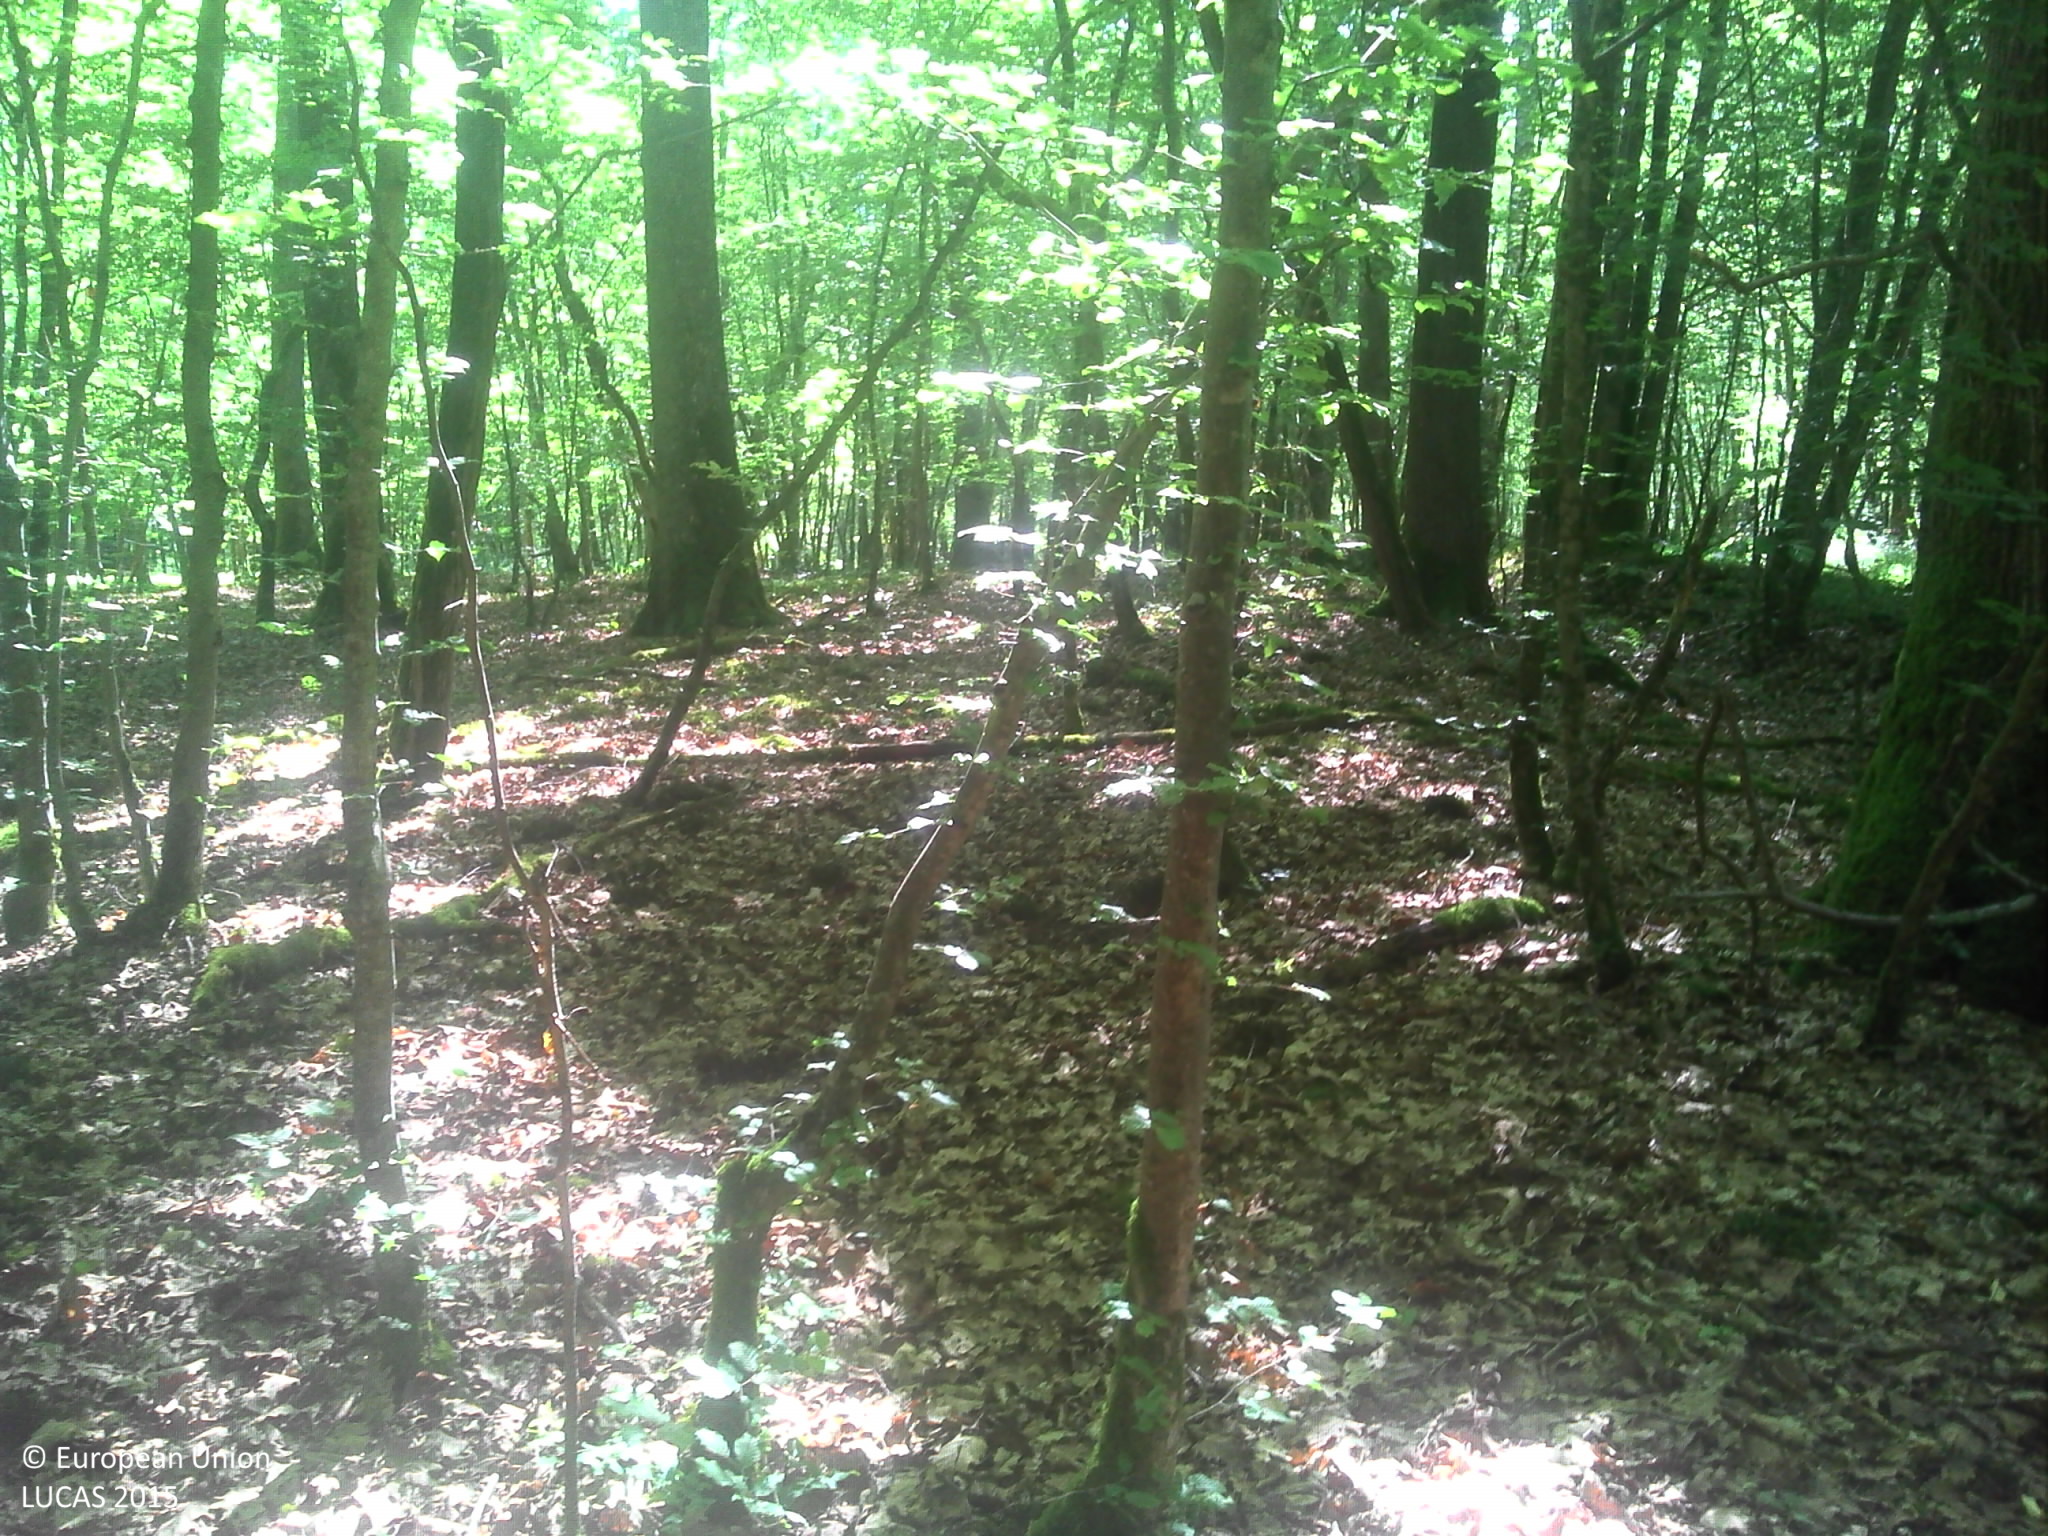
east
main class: Woodland
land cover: Broadleaved woodland
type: acidophilous oak and oak-birch forest
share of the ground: > 75 %
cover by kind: broadleaved forest trees 85 %, herbaceous plants 10 %, coniferous forest trees 5 %
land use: Forestry
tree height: > 5 m
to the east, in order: Broadleaved woodland; Tracks; Broadleaved woodland; Ditches and canals; Tracks; Ditches and canals; Broadleaved woodland
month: June
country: FR
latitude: 48.4034
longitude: 4.7163
